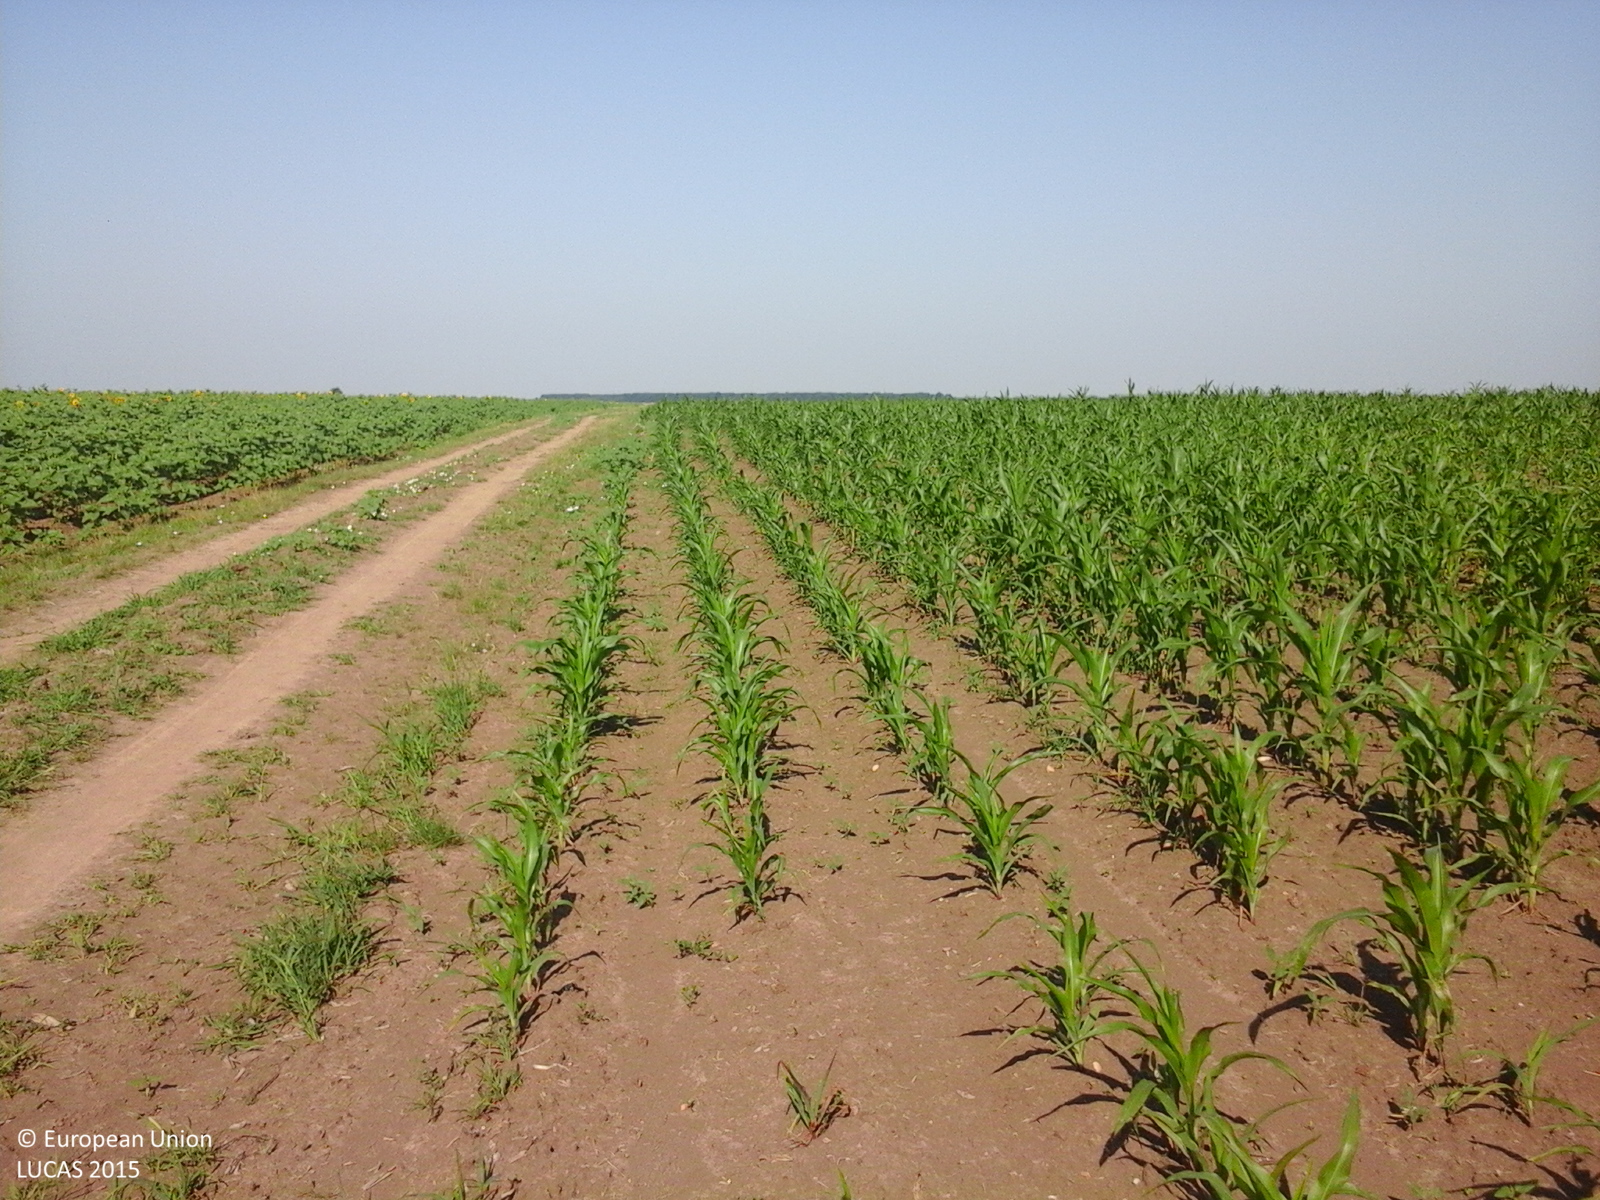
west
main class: Cropland
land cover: Maize
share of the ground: > 75 %
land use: Agriculture (excluding fallow land and kitchen gardens)
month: July
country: RO
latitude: 44.6492
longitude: 24.8446
